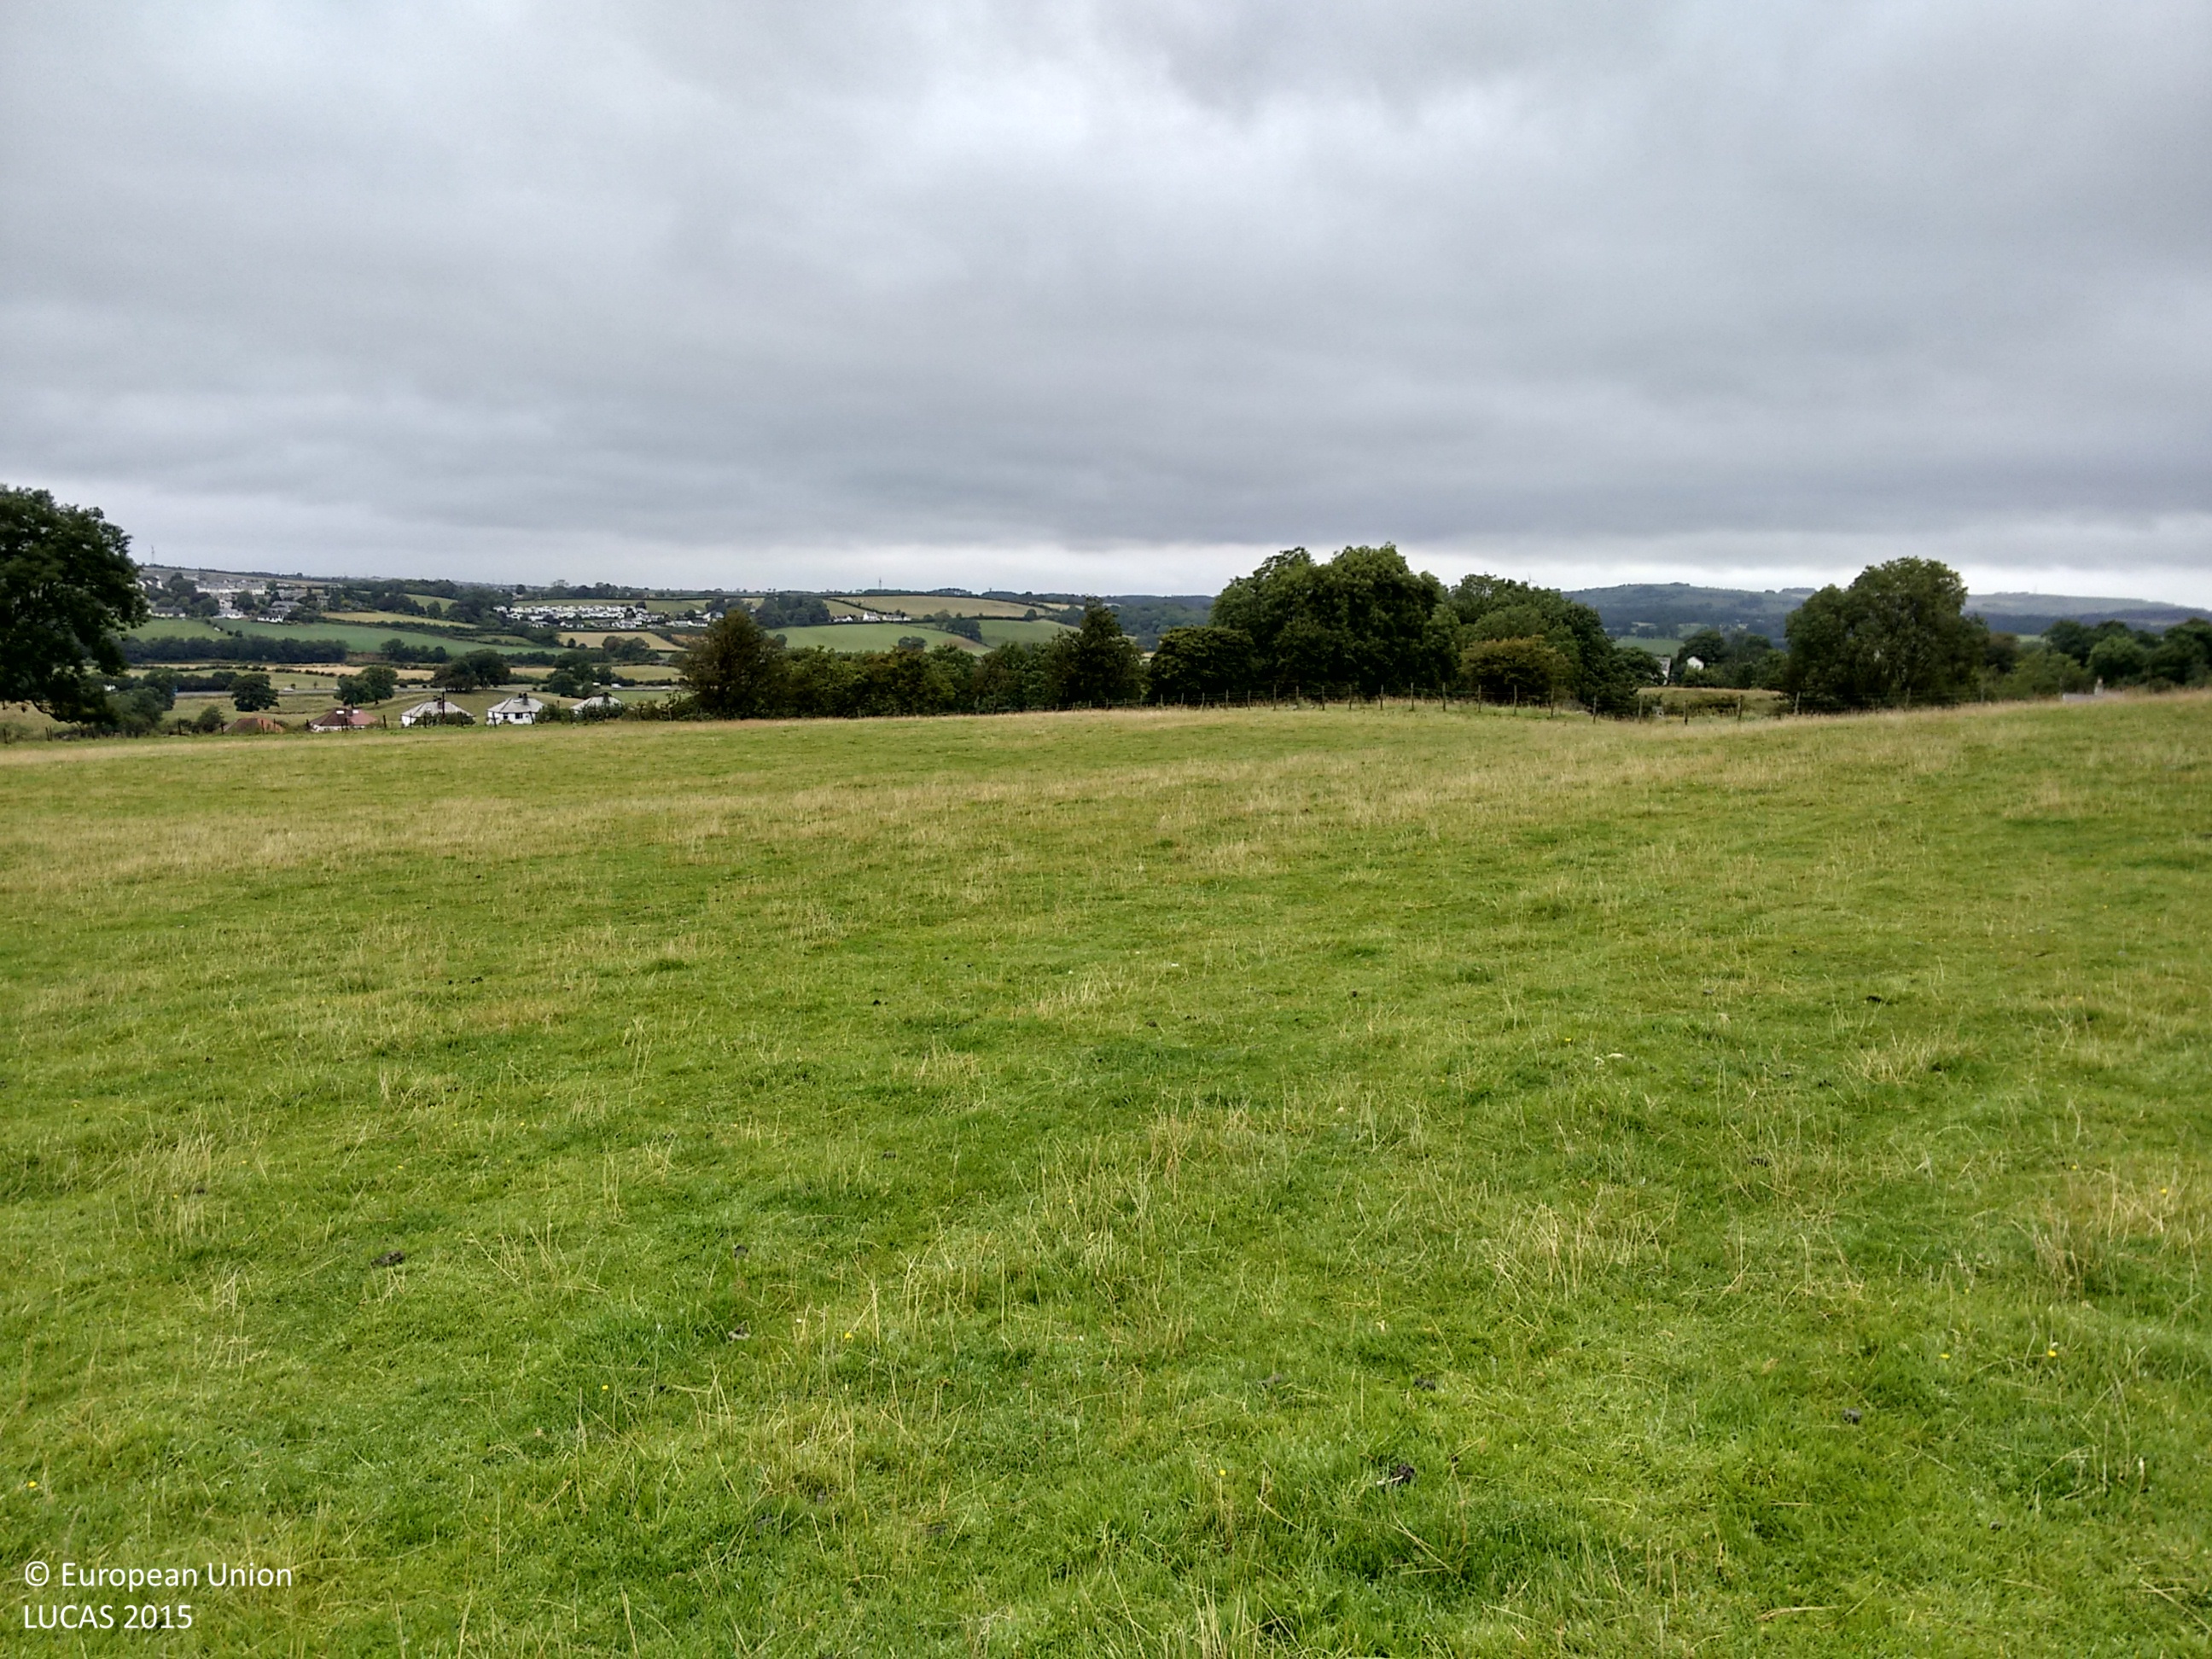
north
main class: Grassland
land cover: Grassland without tree/shrub cover
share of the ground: > 75 %
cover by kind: herbaceous plants 100 %
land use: Agriculture (excluding fallow land and kitchen gardens)
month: August
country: GB
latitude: 54.6565
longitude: -3.4262
